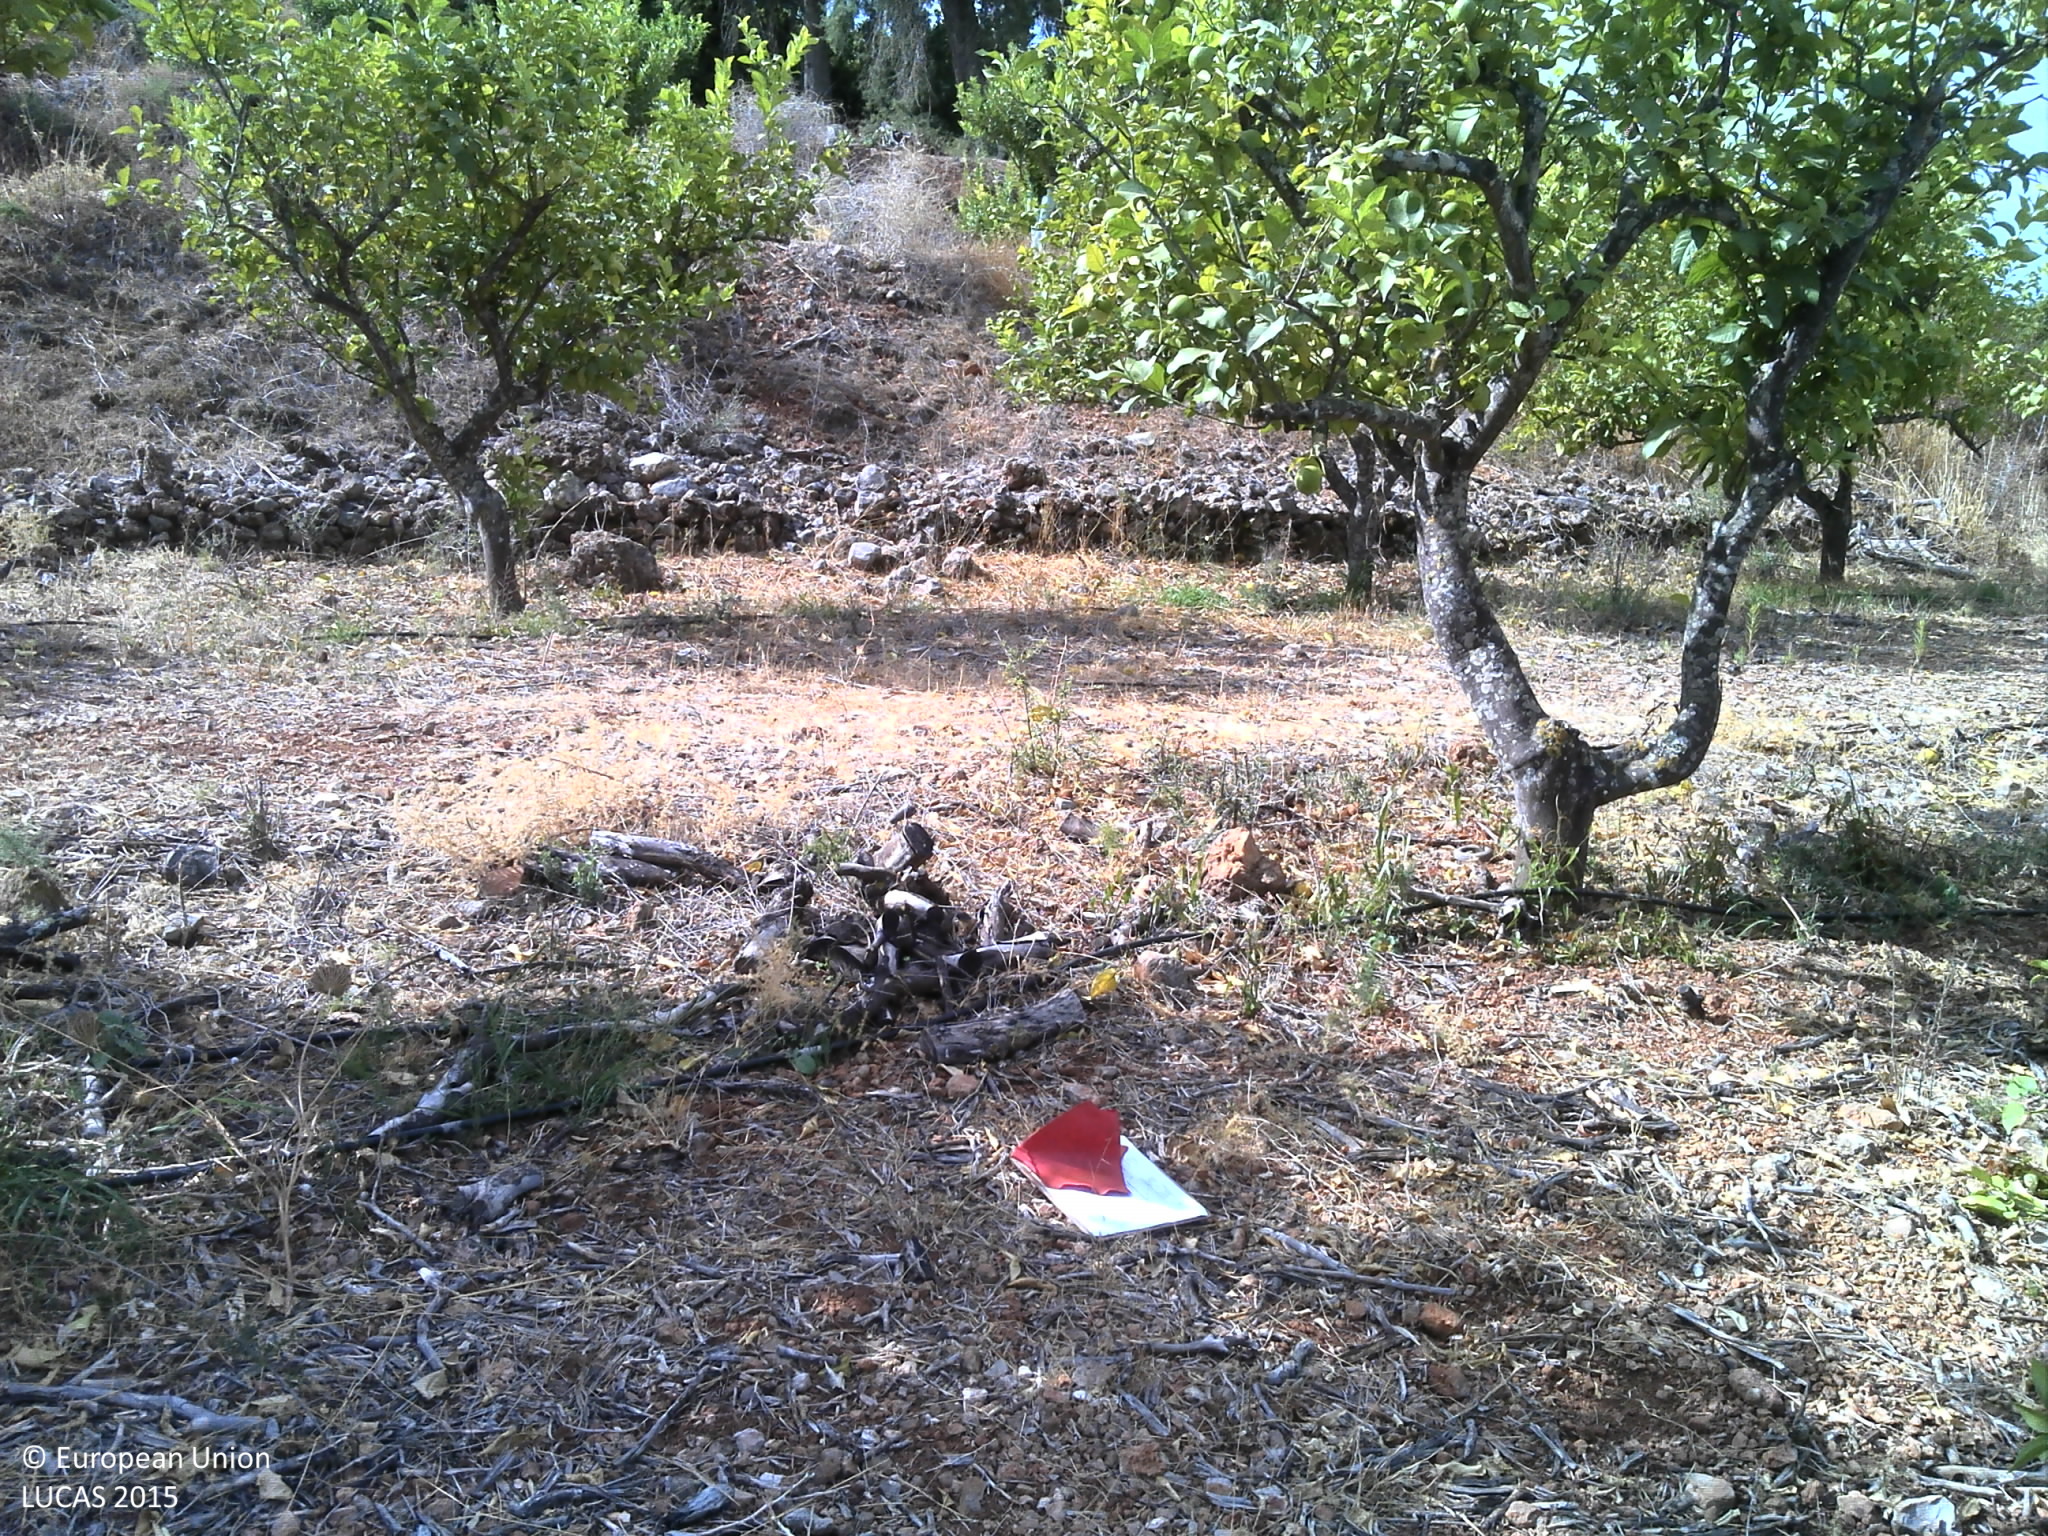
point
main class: Cropland
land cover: Other citrus fruit
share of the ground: 25 - 50 %
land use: Agriculture (excluding fallow land and kitchen gardens)
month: September
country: PT
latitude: 37.1959
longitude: -8.3981
